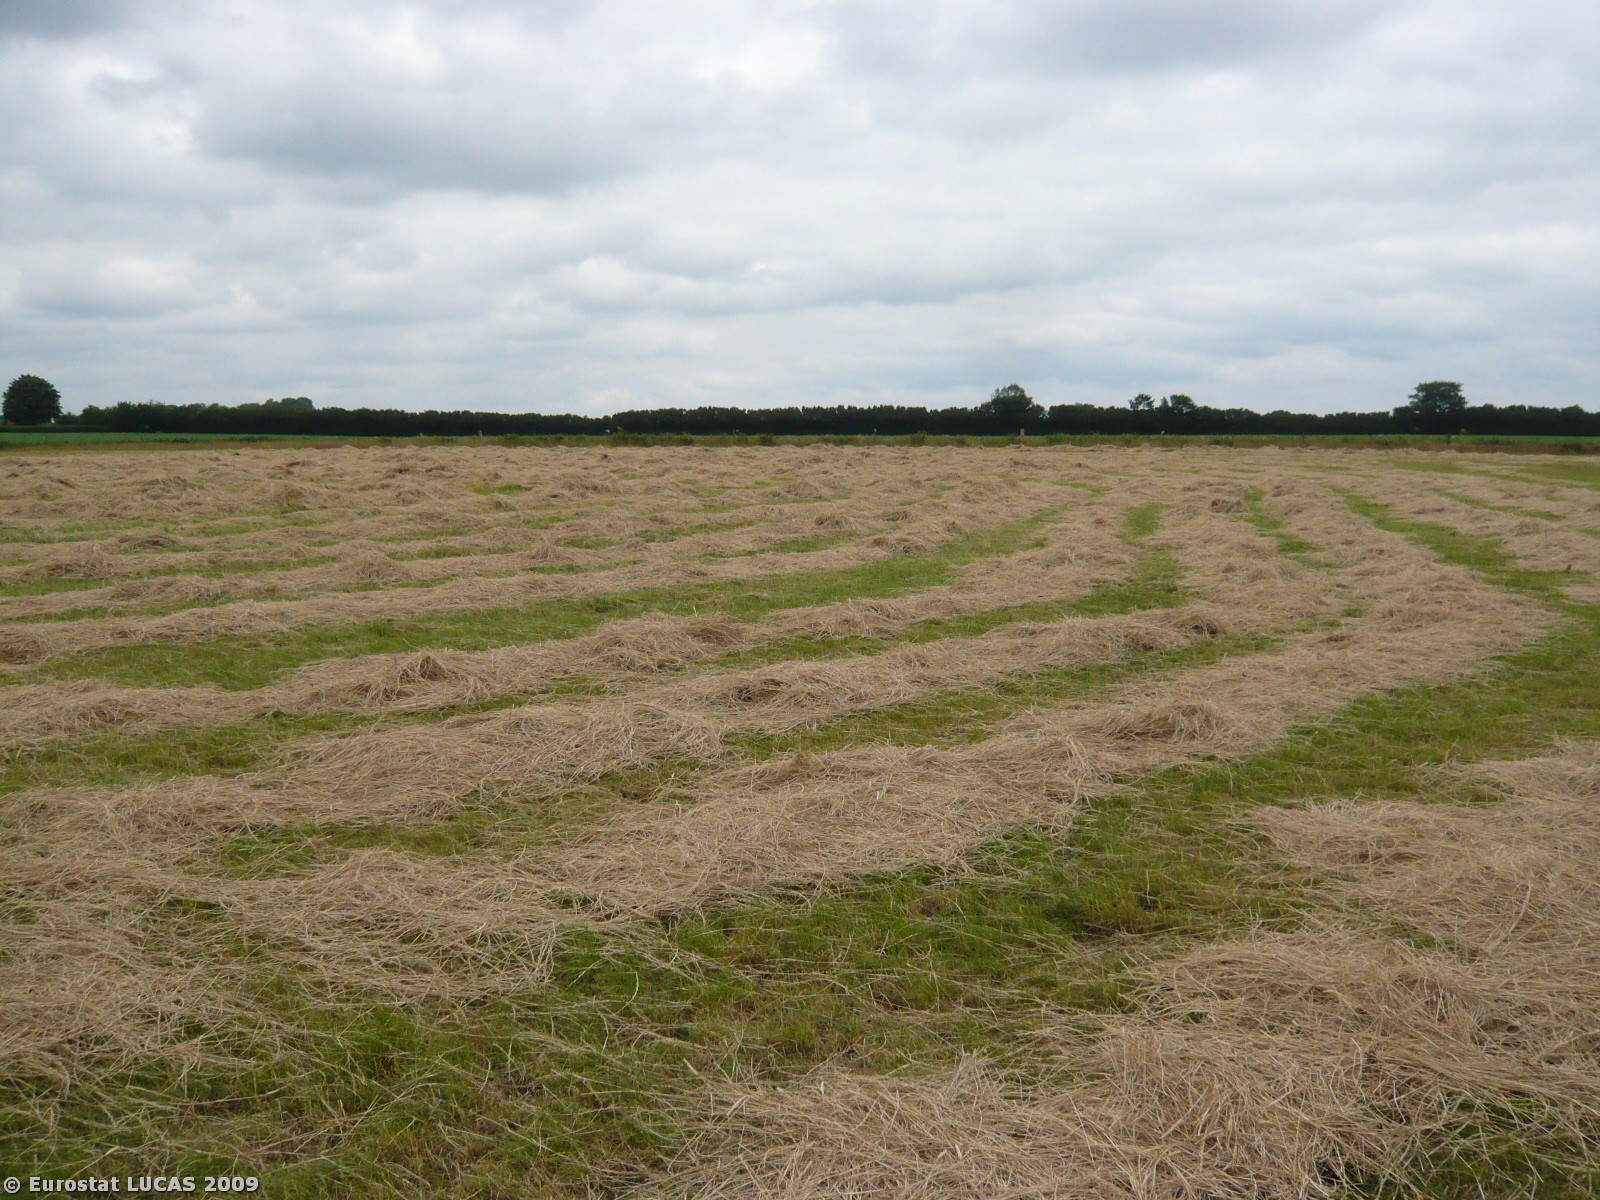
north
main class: Grassland
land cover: Grassland without tree/shrub cover
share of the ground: > 75 %
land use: Agriculture (excluding fallow land and kitchen gardens)
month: June
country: DK
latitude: 55.2708
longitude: 10.2673
